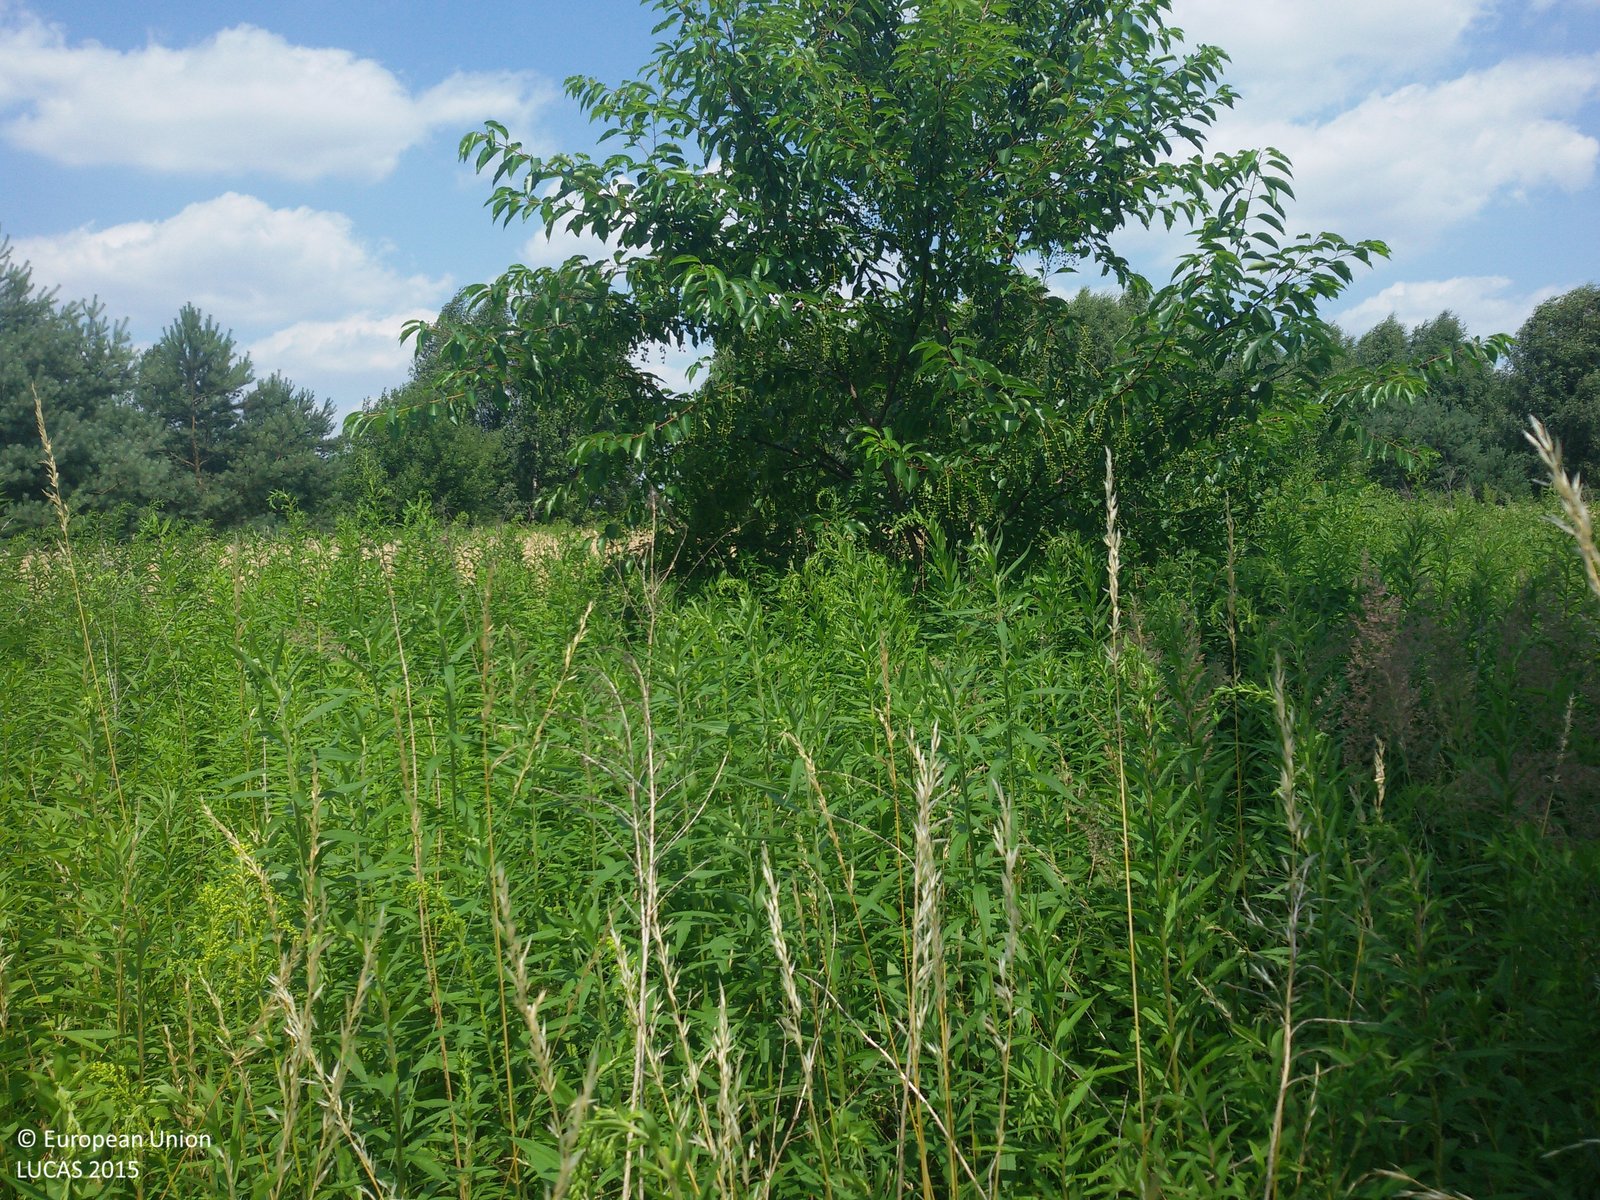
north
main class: Grassland
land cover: Spontaneously vegetated surfaces
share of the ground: > 75 %
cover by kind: herbaceous plants 95 %, shrubs 5 %
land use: Semi-natural and natural areas not in use
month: July
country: PL
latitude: 51.7328
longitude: 19.8338
